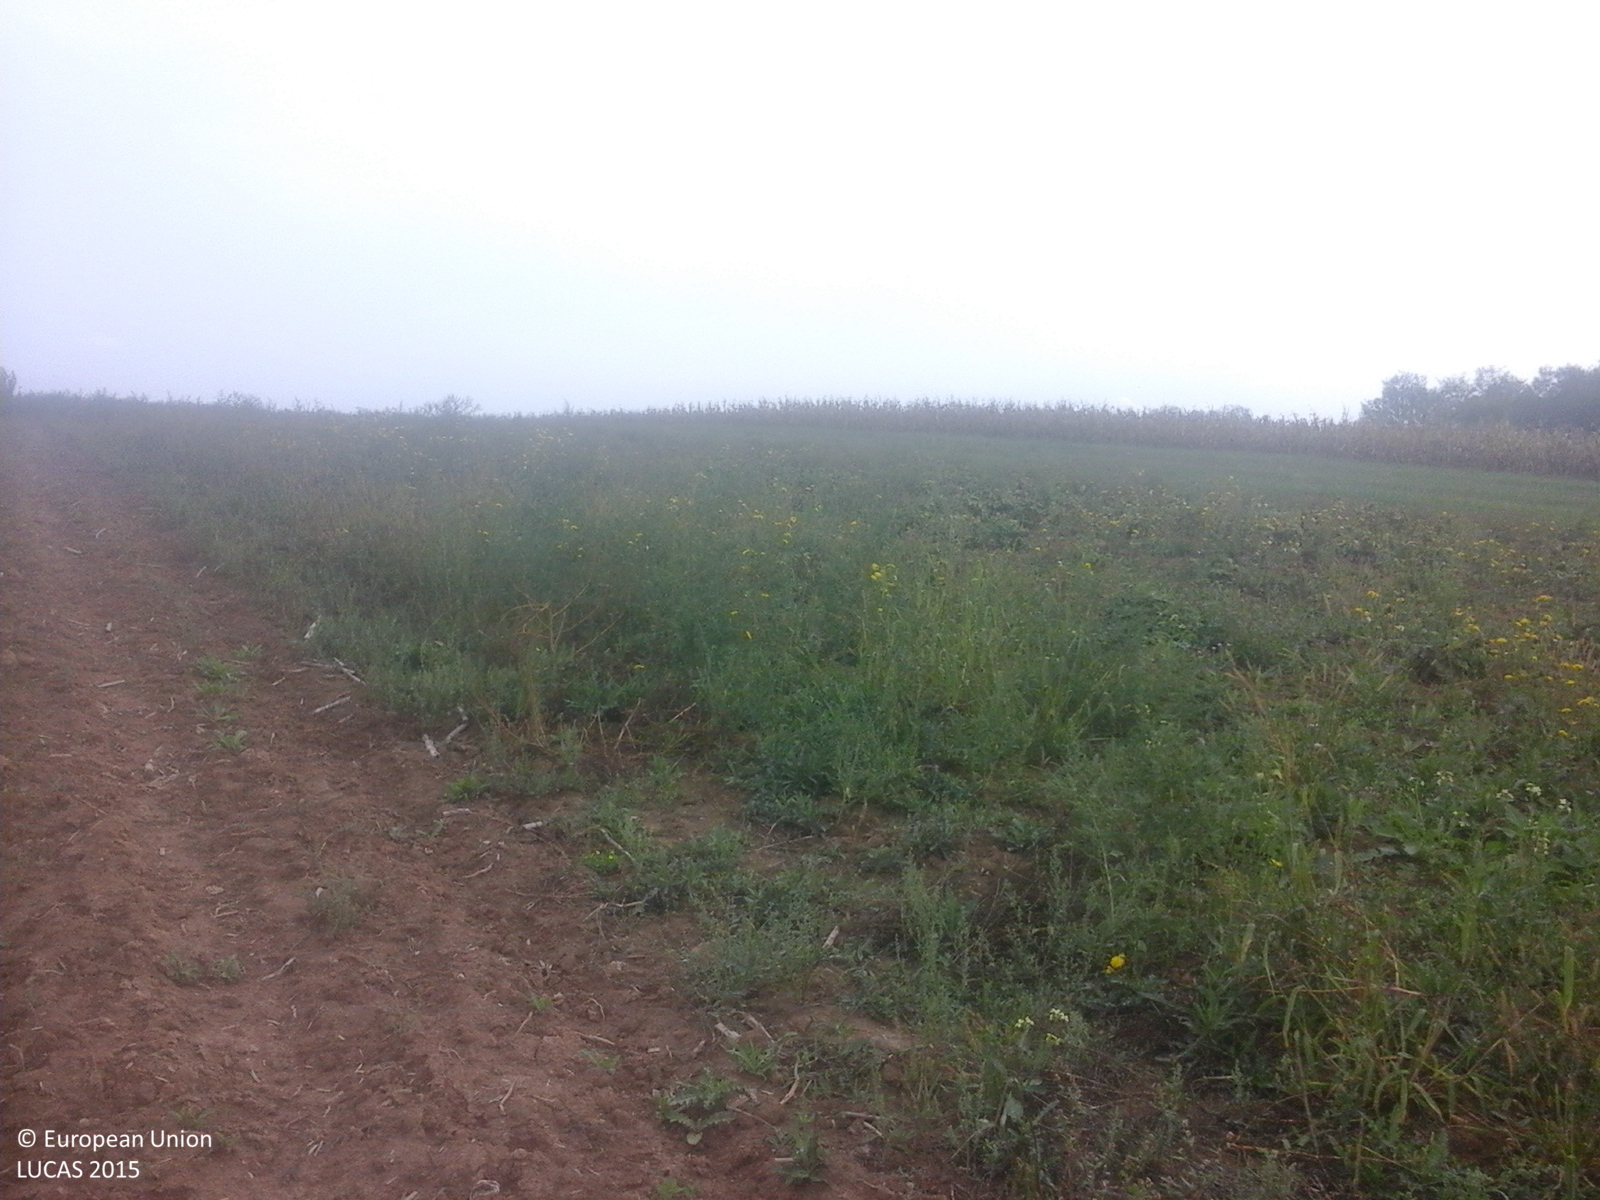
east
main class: Cropland
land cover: Potatoes
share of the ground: < 10 %
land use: Agriculture (excluding fallow land and kitchen gardens)
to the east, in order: Potatoes; Other fresh vegetables; Common wheat; Maize; Grassland without tree/shrub cover; Spontaneously vegetated surfaces
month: September
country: RO
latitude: 45.8339
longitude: 22.1832
